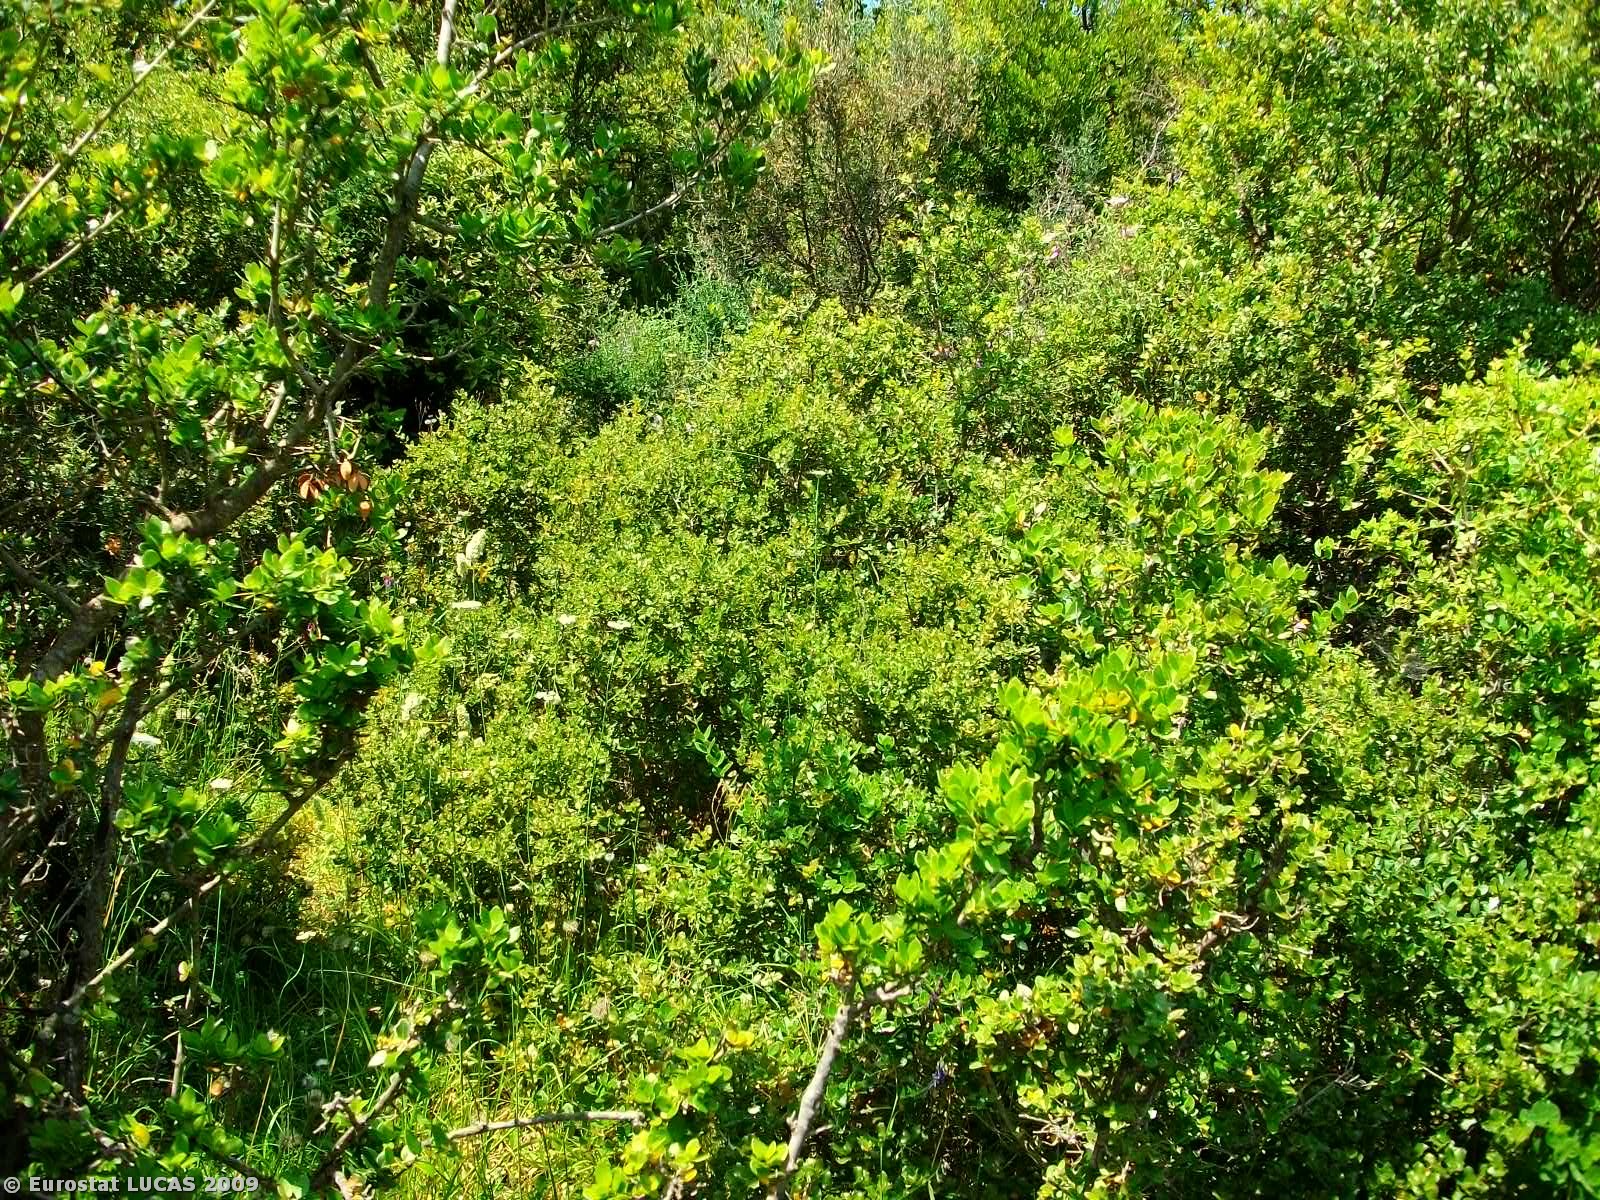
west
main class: Shrubland
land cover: Shrubland with sparse tree cover
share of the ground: > 75 %
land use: Agriculture (excluding fallow land and kitchen gardens)
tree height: > 5 m
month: May
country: GR
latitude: 38.6726
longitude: 21.5226
